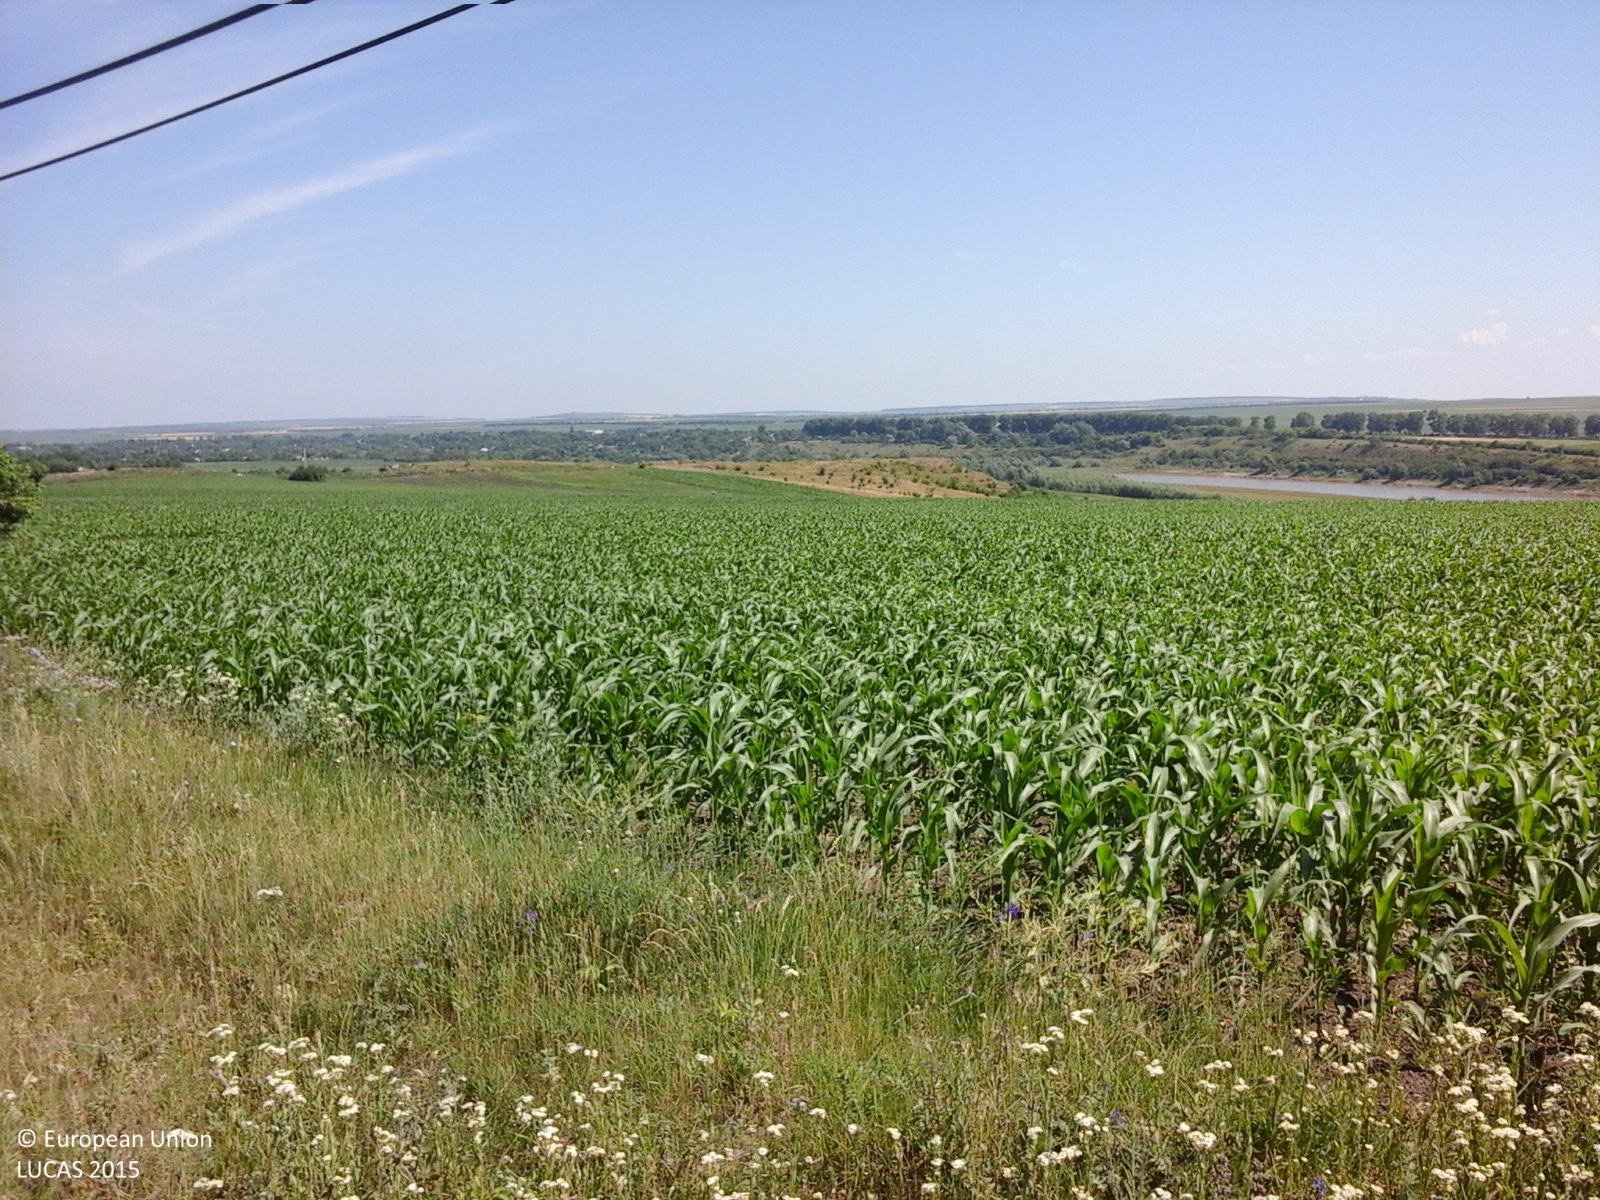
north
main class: Cropland
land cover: Maize
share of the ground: > 75 %
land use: Agriculture (excluding fallow land and kitchen gardens)
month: June
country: RO
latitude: 48.0367
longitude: 27.0752
